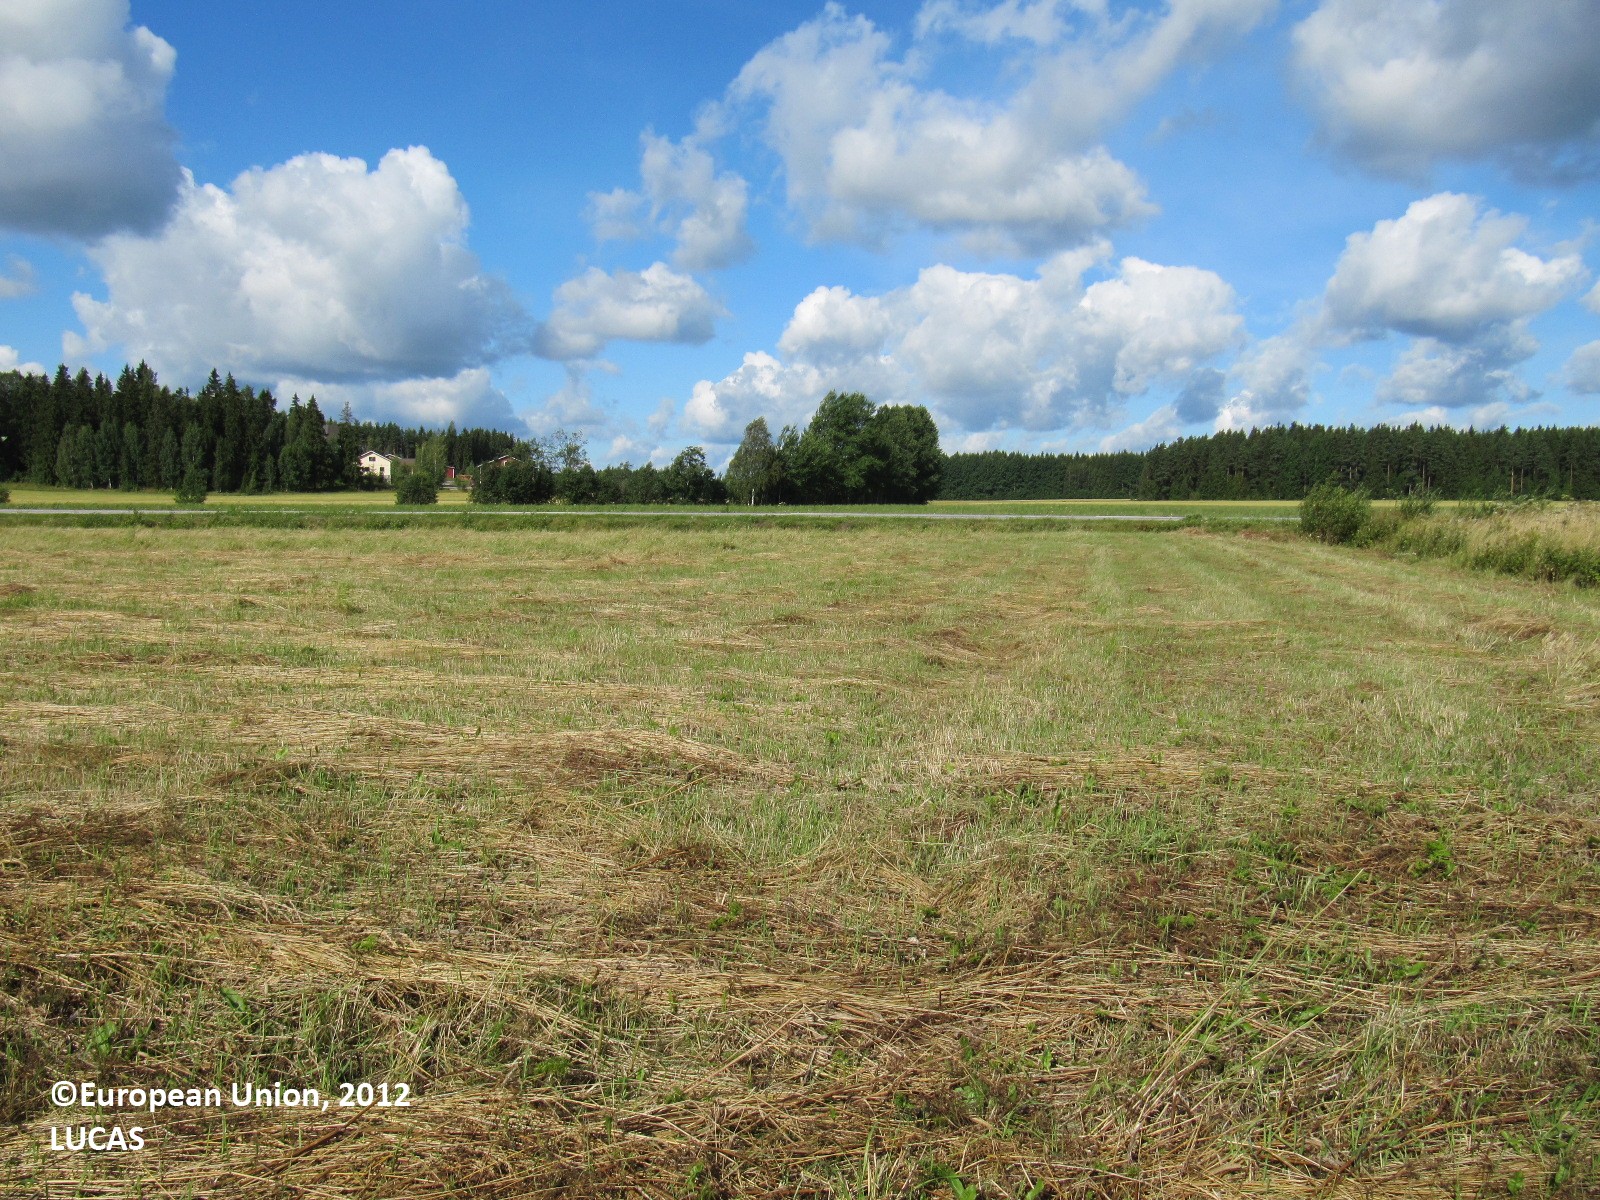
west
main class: Grassland
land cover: Spontaneously vegetated surfaces
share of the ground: > 75 %
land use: Fallow land
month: August
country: FI
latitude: 60.4751
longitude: 23.1606
